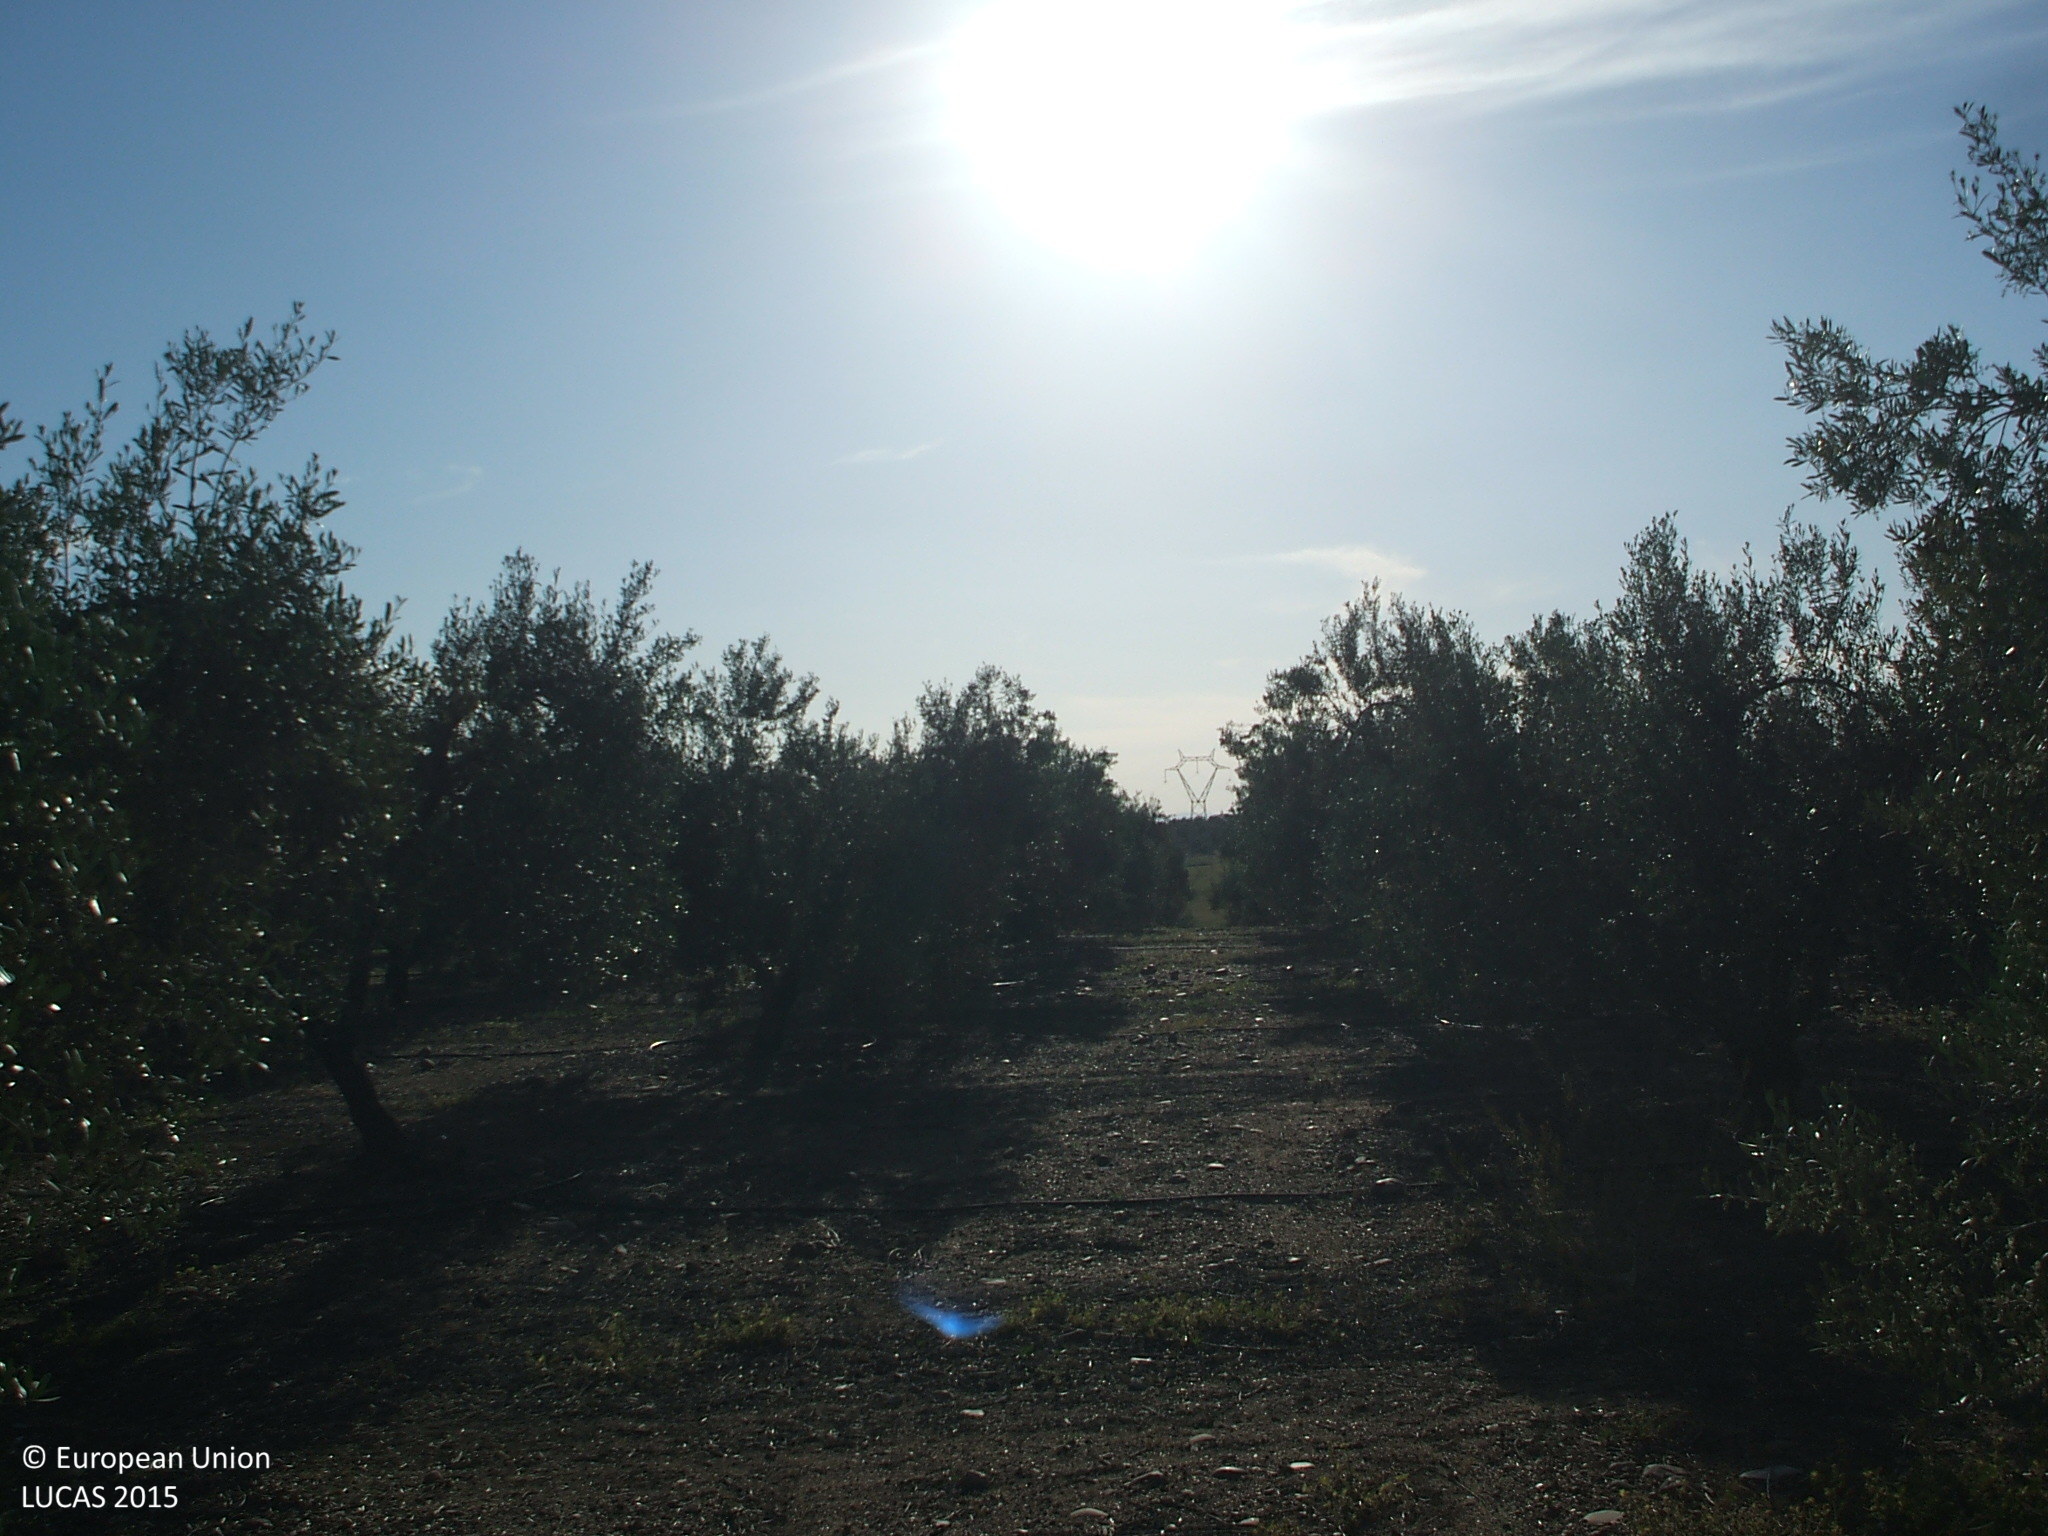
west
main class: Cropland
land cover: Olive groves
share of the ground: > 75 %
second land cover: Spontaneously vegetated surfaces
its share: > 75 %
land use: Agriculture (excluding fallow land and kitchen gardens)
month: April
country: ES
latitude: 37.6204
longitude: -5.4390
